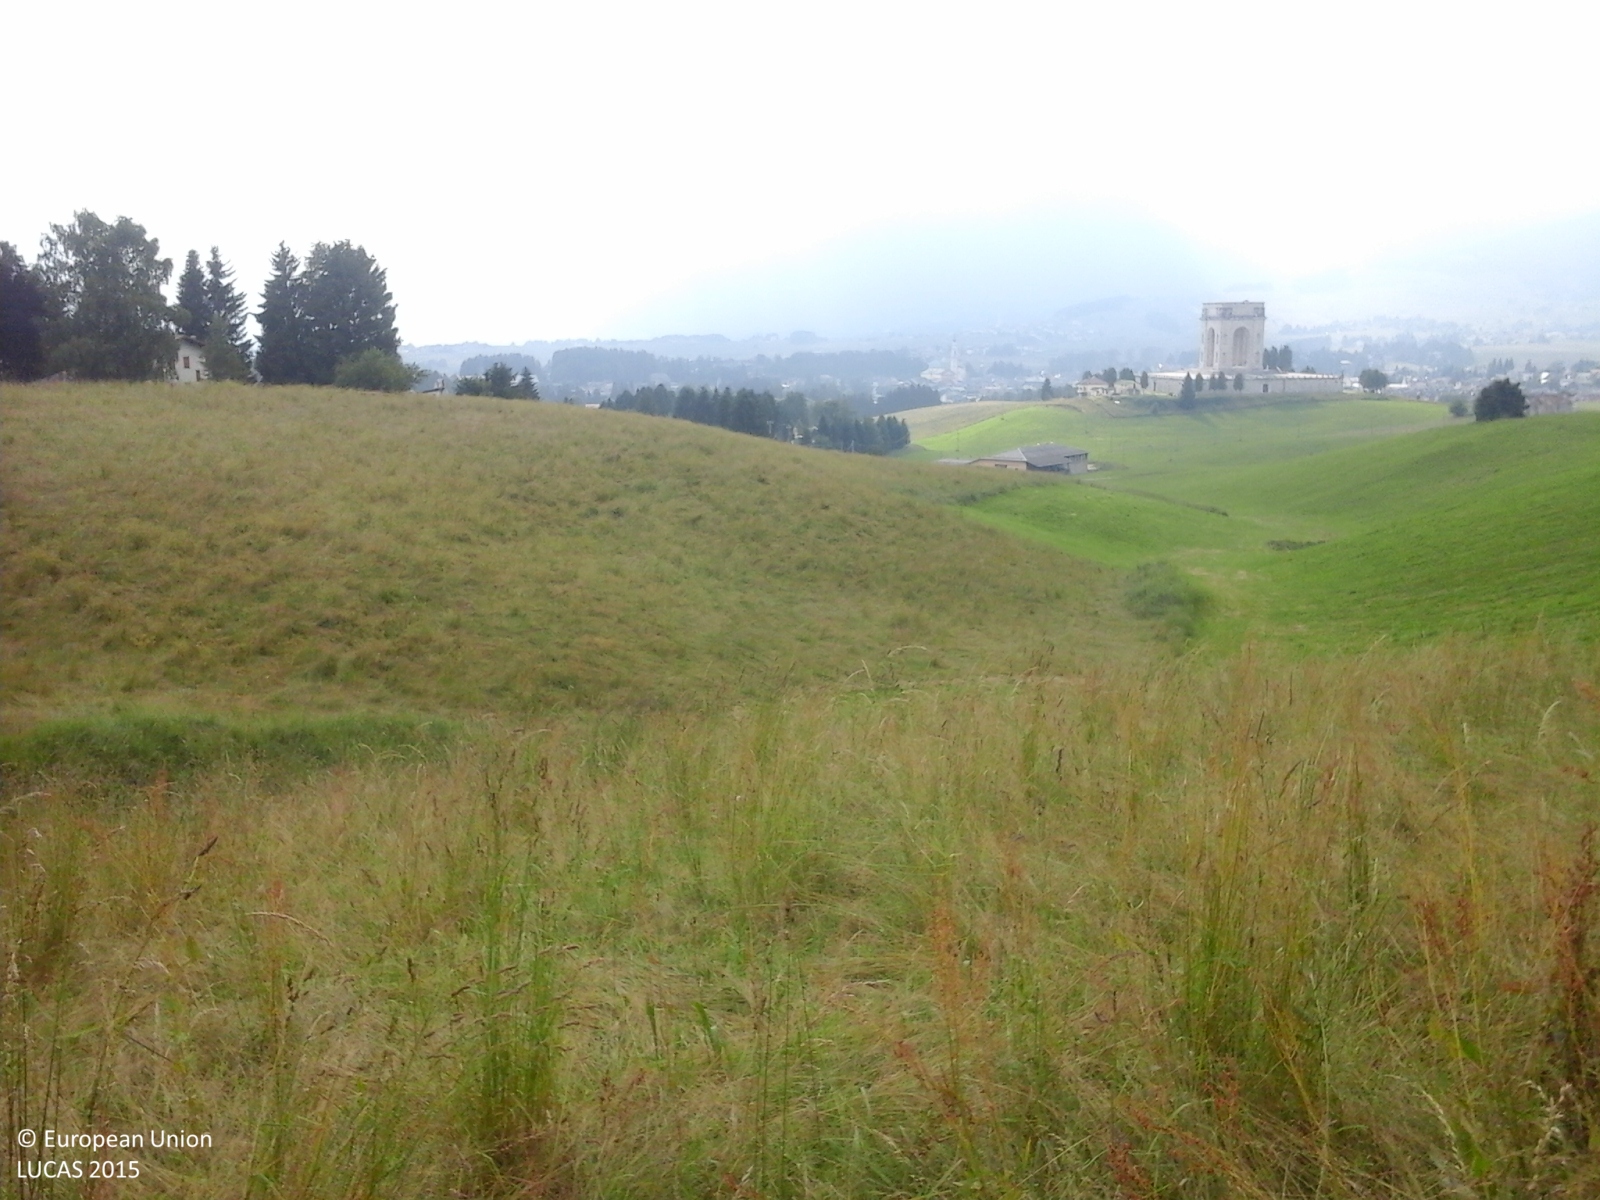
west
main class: Grassland
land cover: Grassland without tree/shrub cover
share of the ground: > 75 %
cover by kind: herbaceous plants 100 %
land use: Agriculture (excluding fallow land and kitchen gardens)
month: June
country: IT
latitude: 45.8718
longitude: 11.5308
